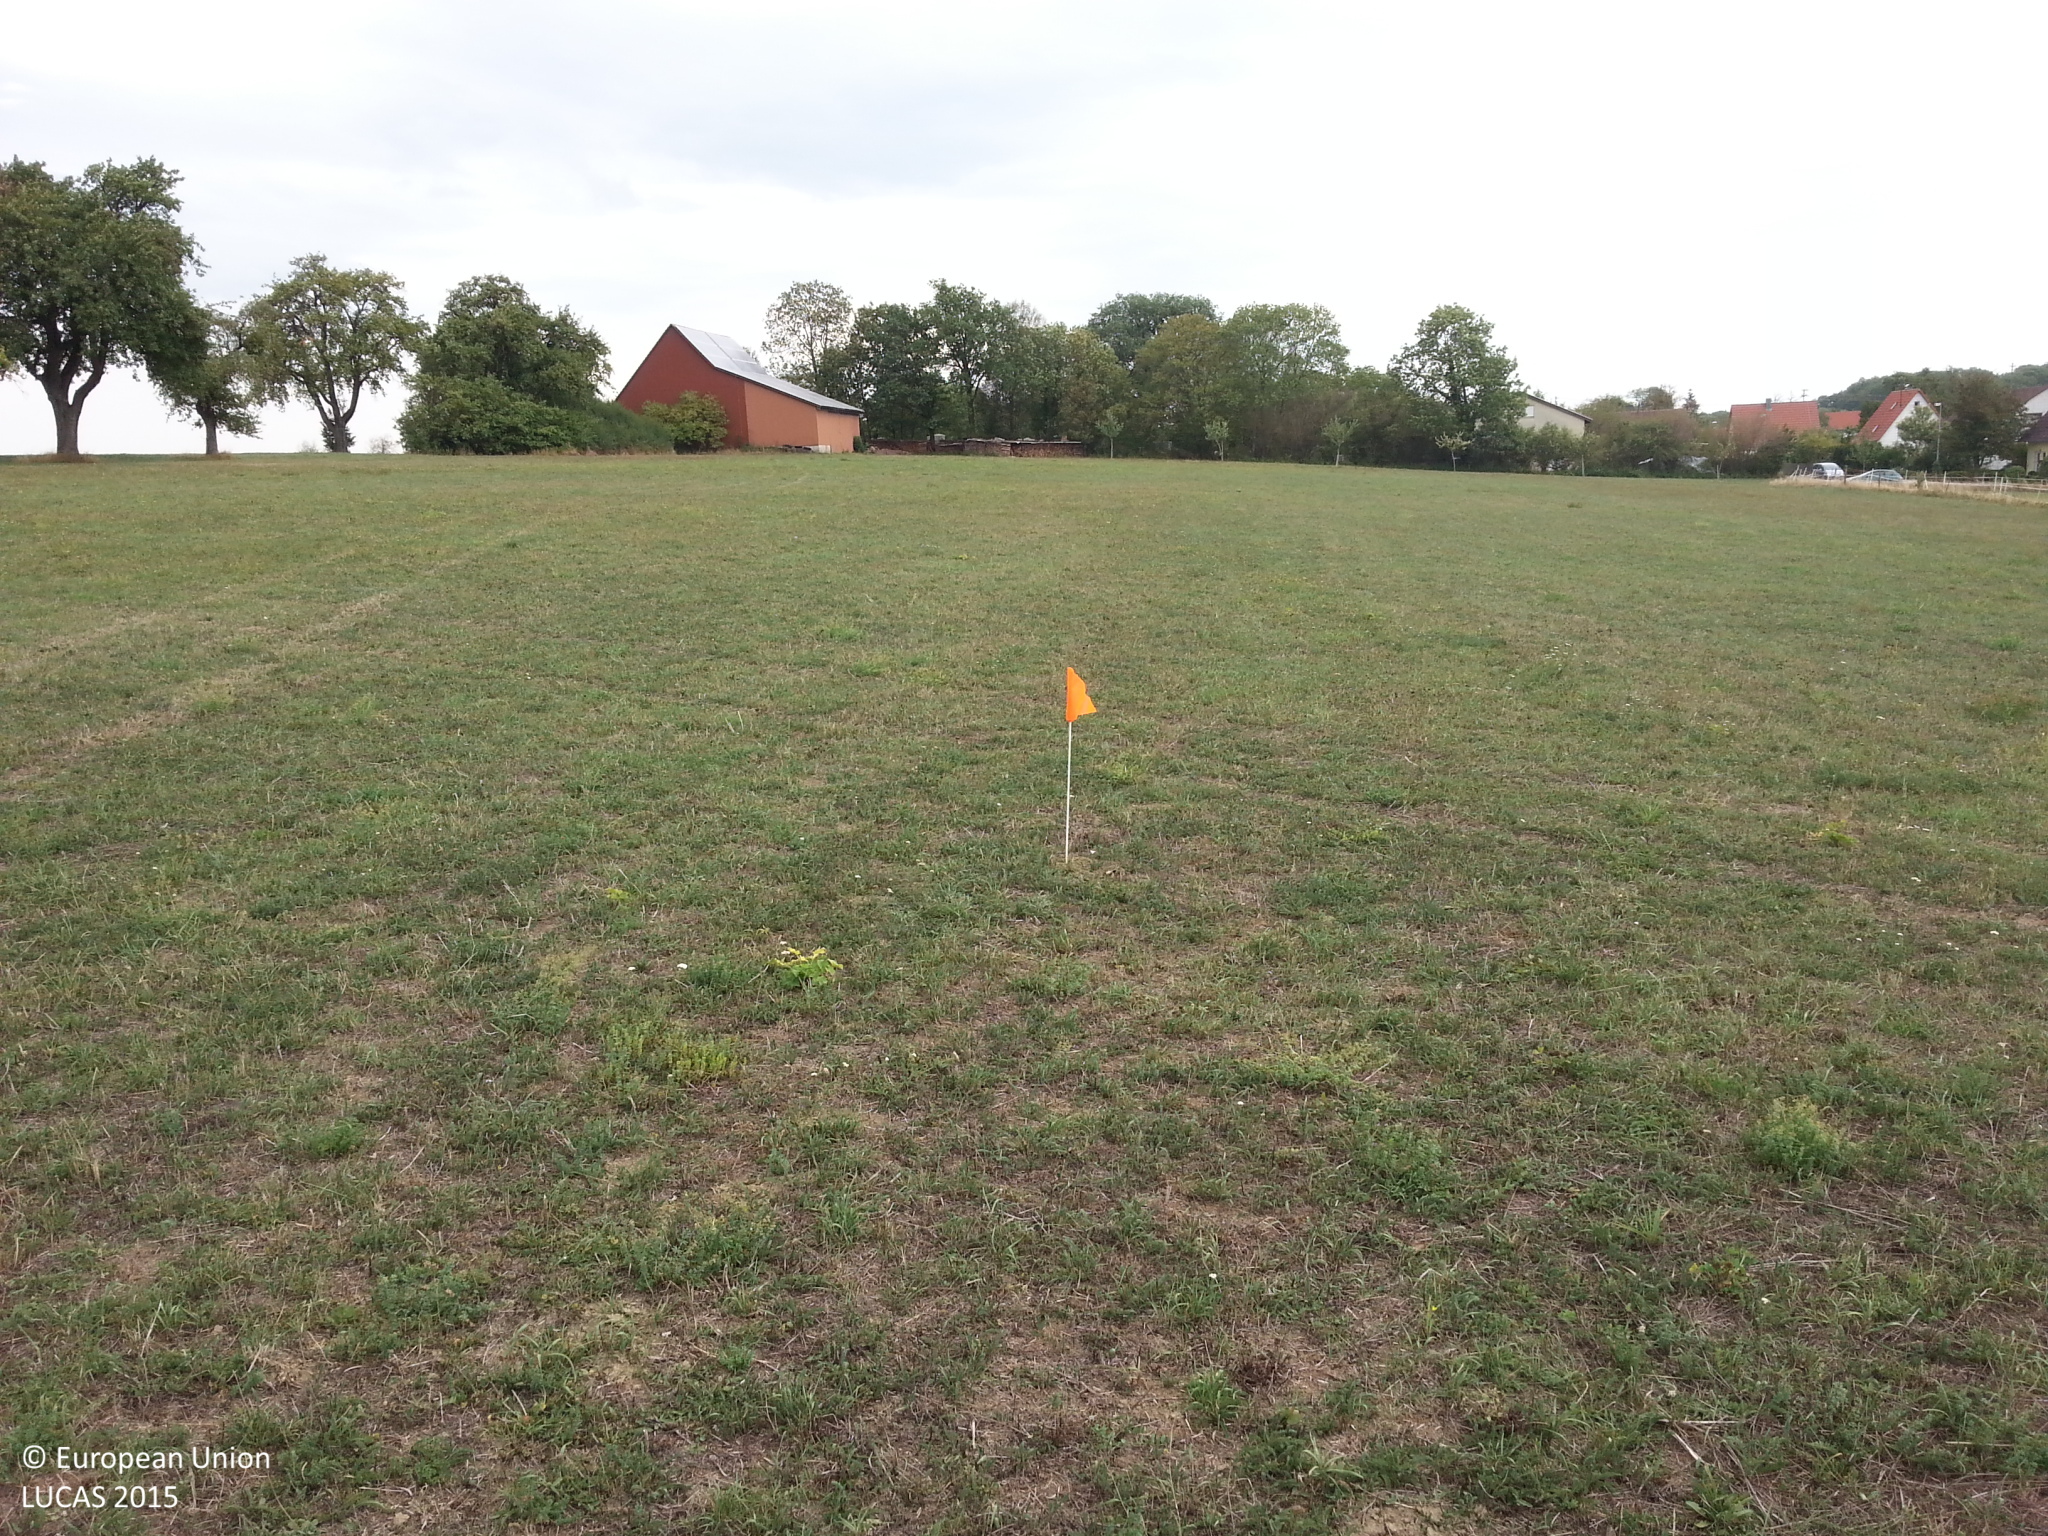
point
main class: Grassland
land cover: Grassland without tree/shrub cover
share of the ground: > 75 %
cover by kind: herbaceous plants 90 %, unconsolidated bare surface 10 %
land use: Agriculture (excluding fallow land and kitchen gardens)
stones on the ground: < 10 %
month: September
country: DE
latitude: 49.2670
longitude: 9.9588
